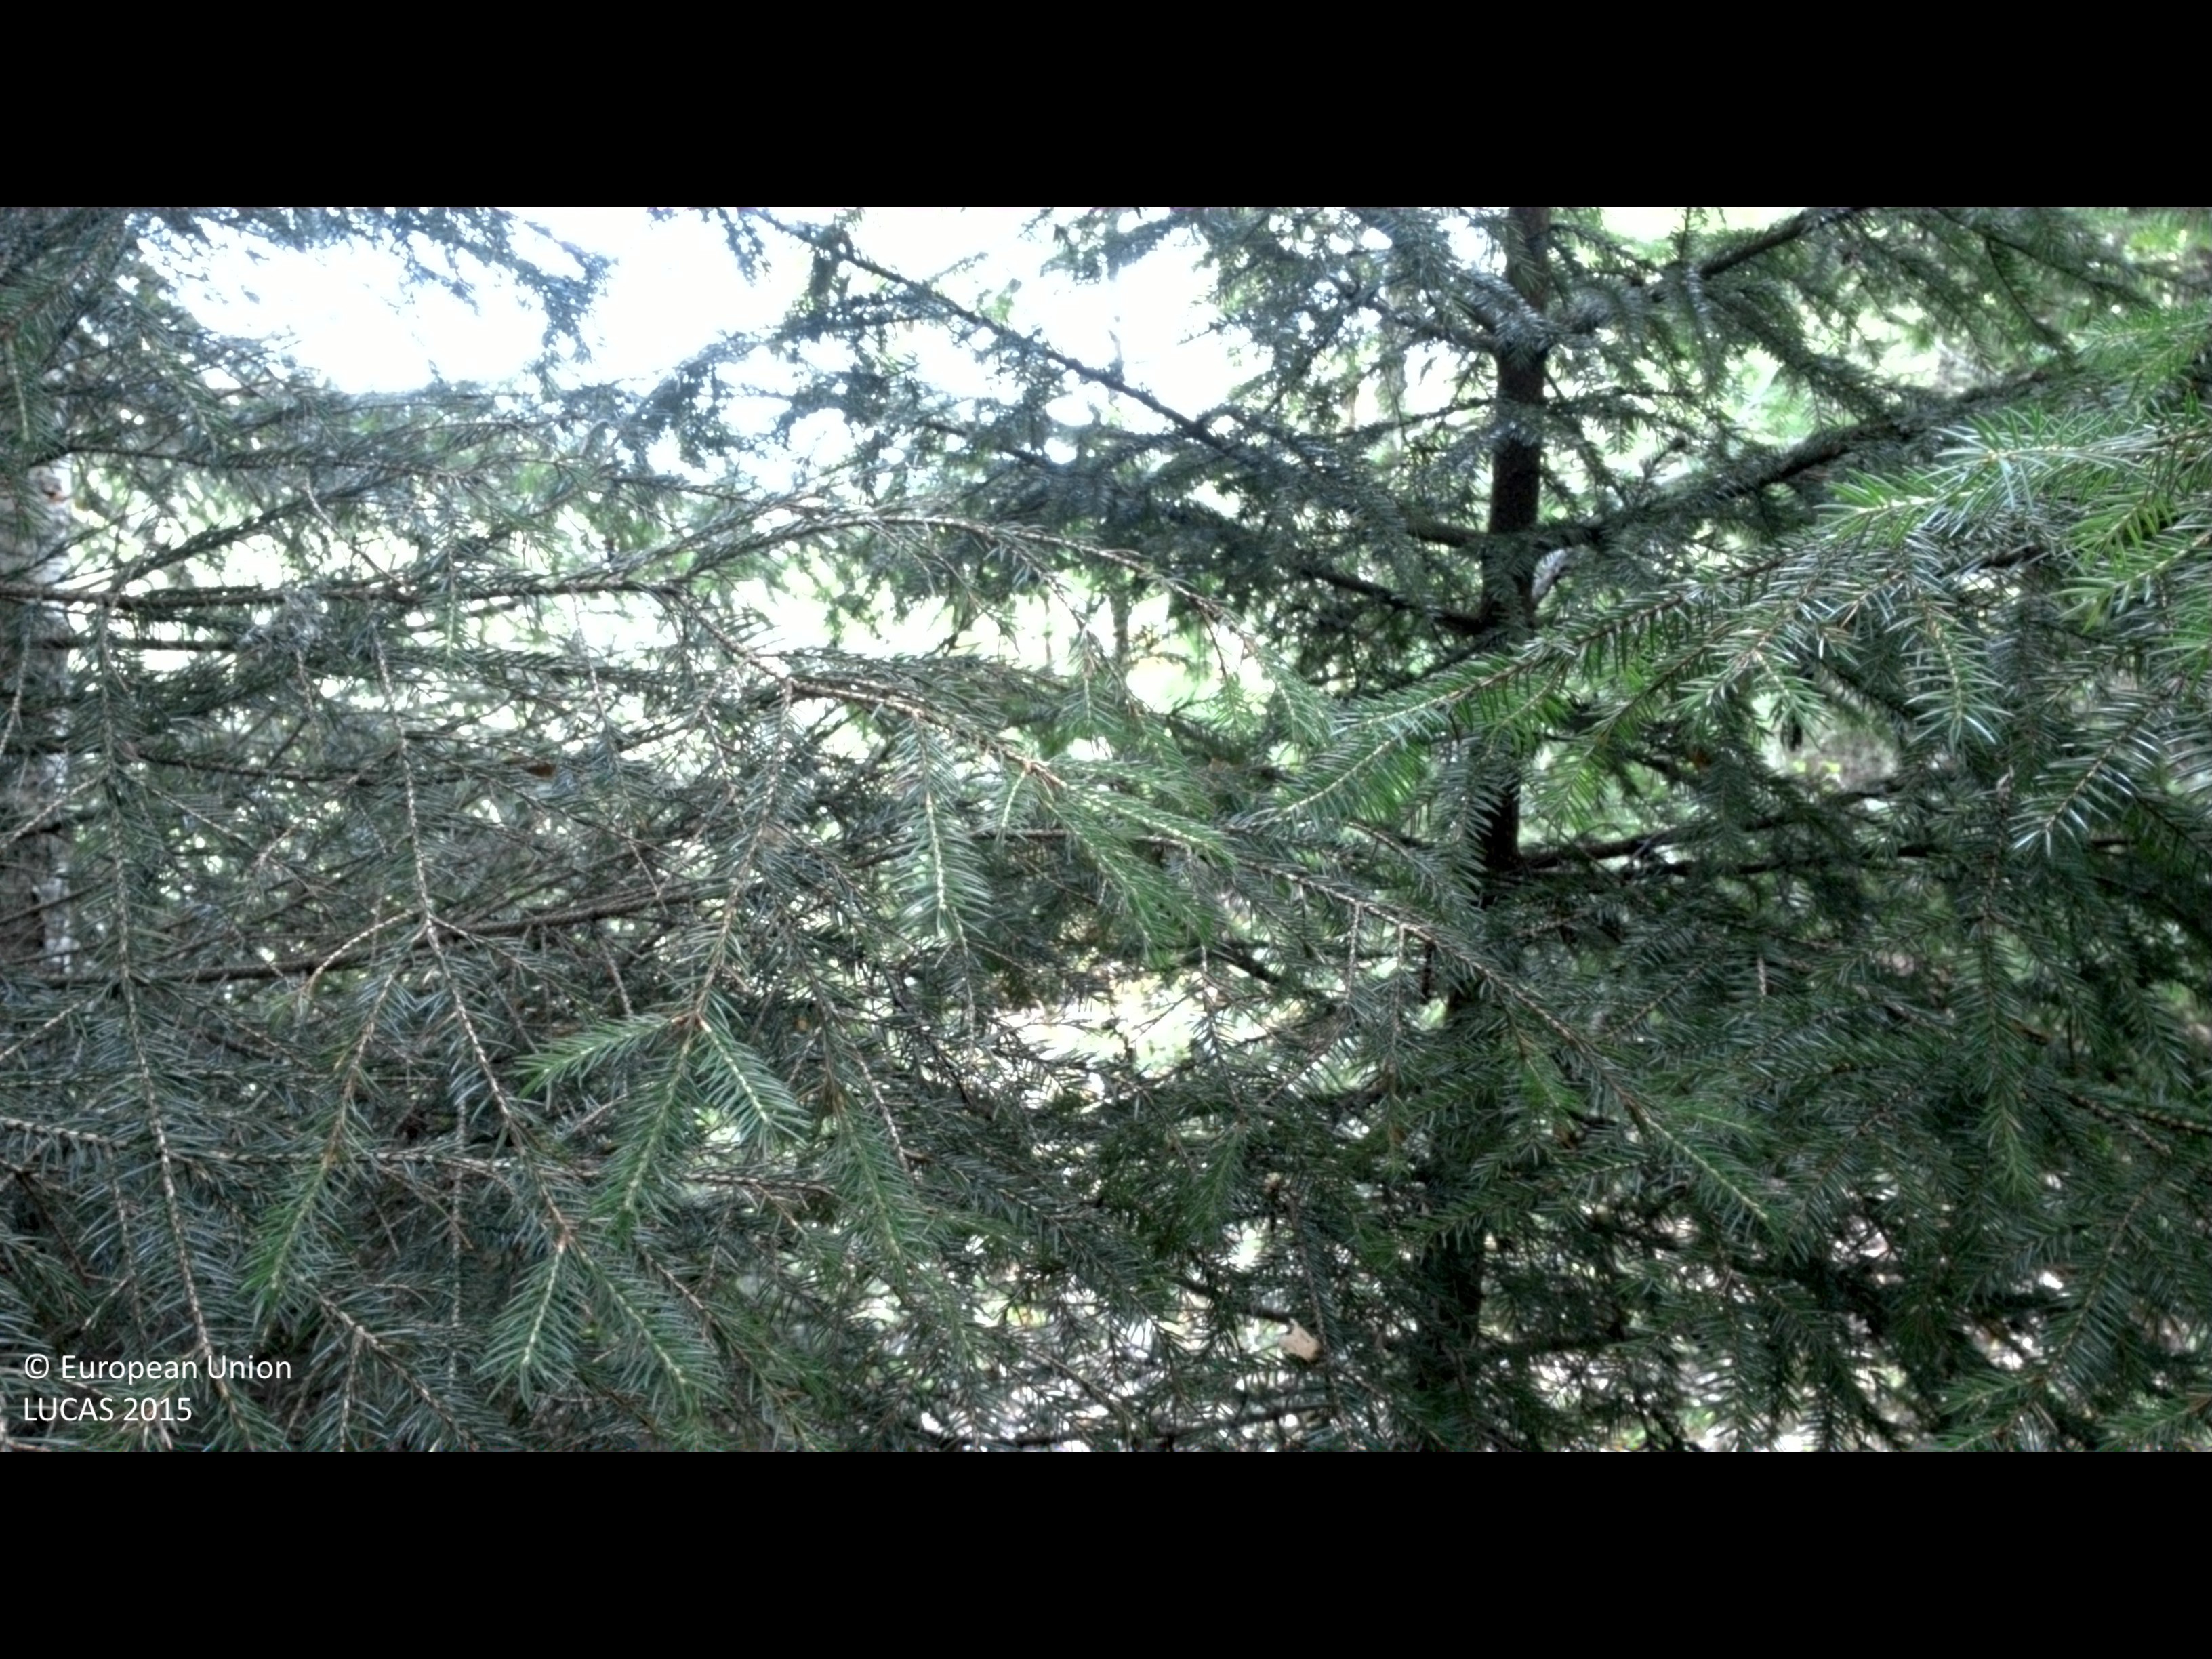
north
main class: Woodland
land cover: Spruce dominated mixed woodland
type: boreal forest
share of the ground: > 75 %
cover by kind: coniferous forest trees 40 %, broadleaved forest trees 40 %, shrubs 15 %, herbaceous plants 5 %
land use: Forestry
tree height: > 5 m
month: July
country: SE
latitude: 58.1503
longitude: 16.1639
